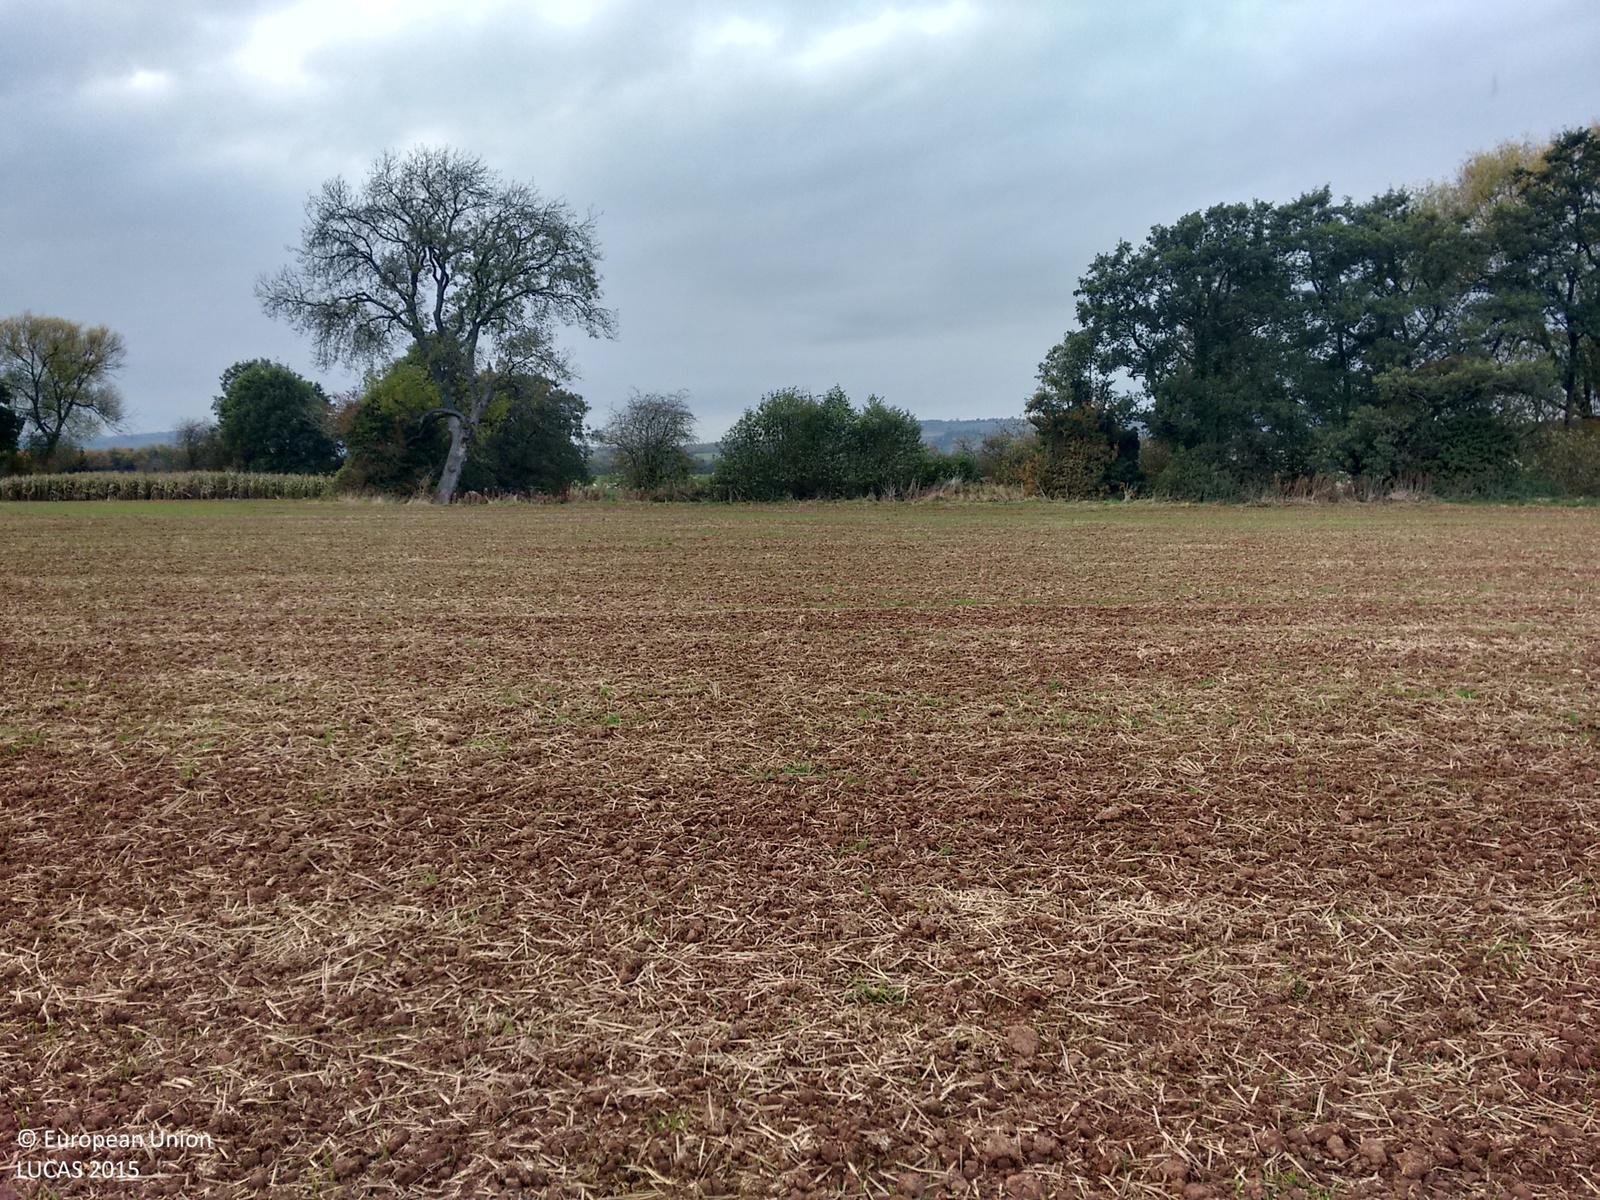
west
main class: Cropland
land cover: Oats
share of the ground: < 10 %
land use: Agriculture (excluding fallow land and kitchen gardens)
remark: Tilled/Sowed
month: October
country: GB
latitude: 52.4347
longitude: -2.7347
